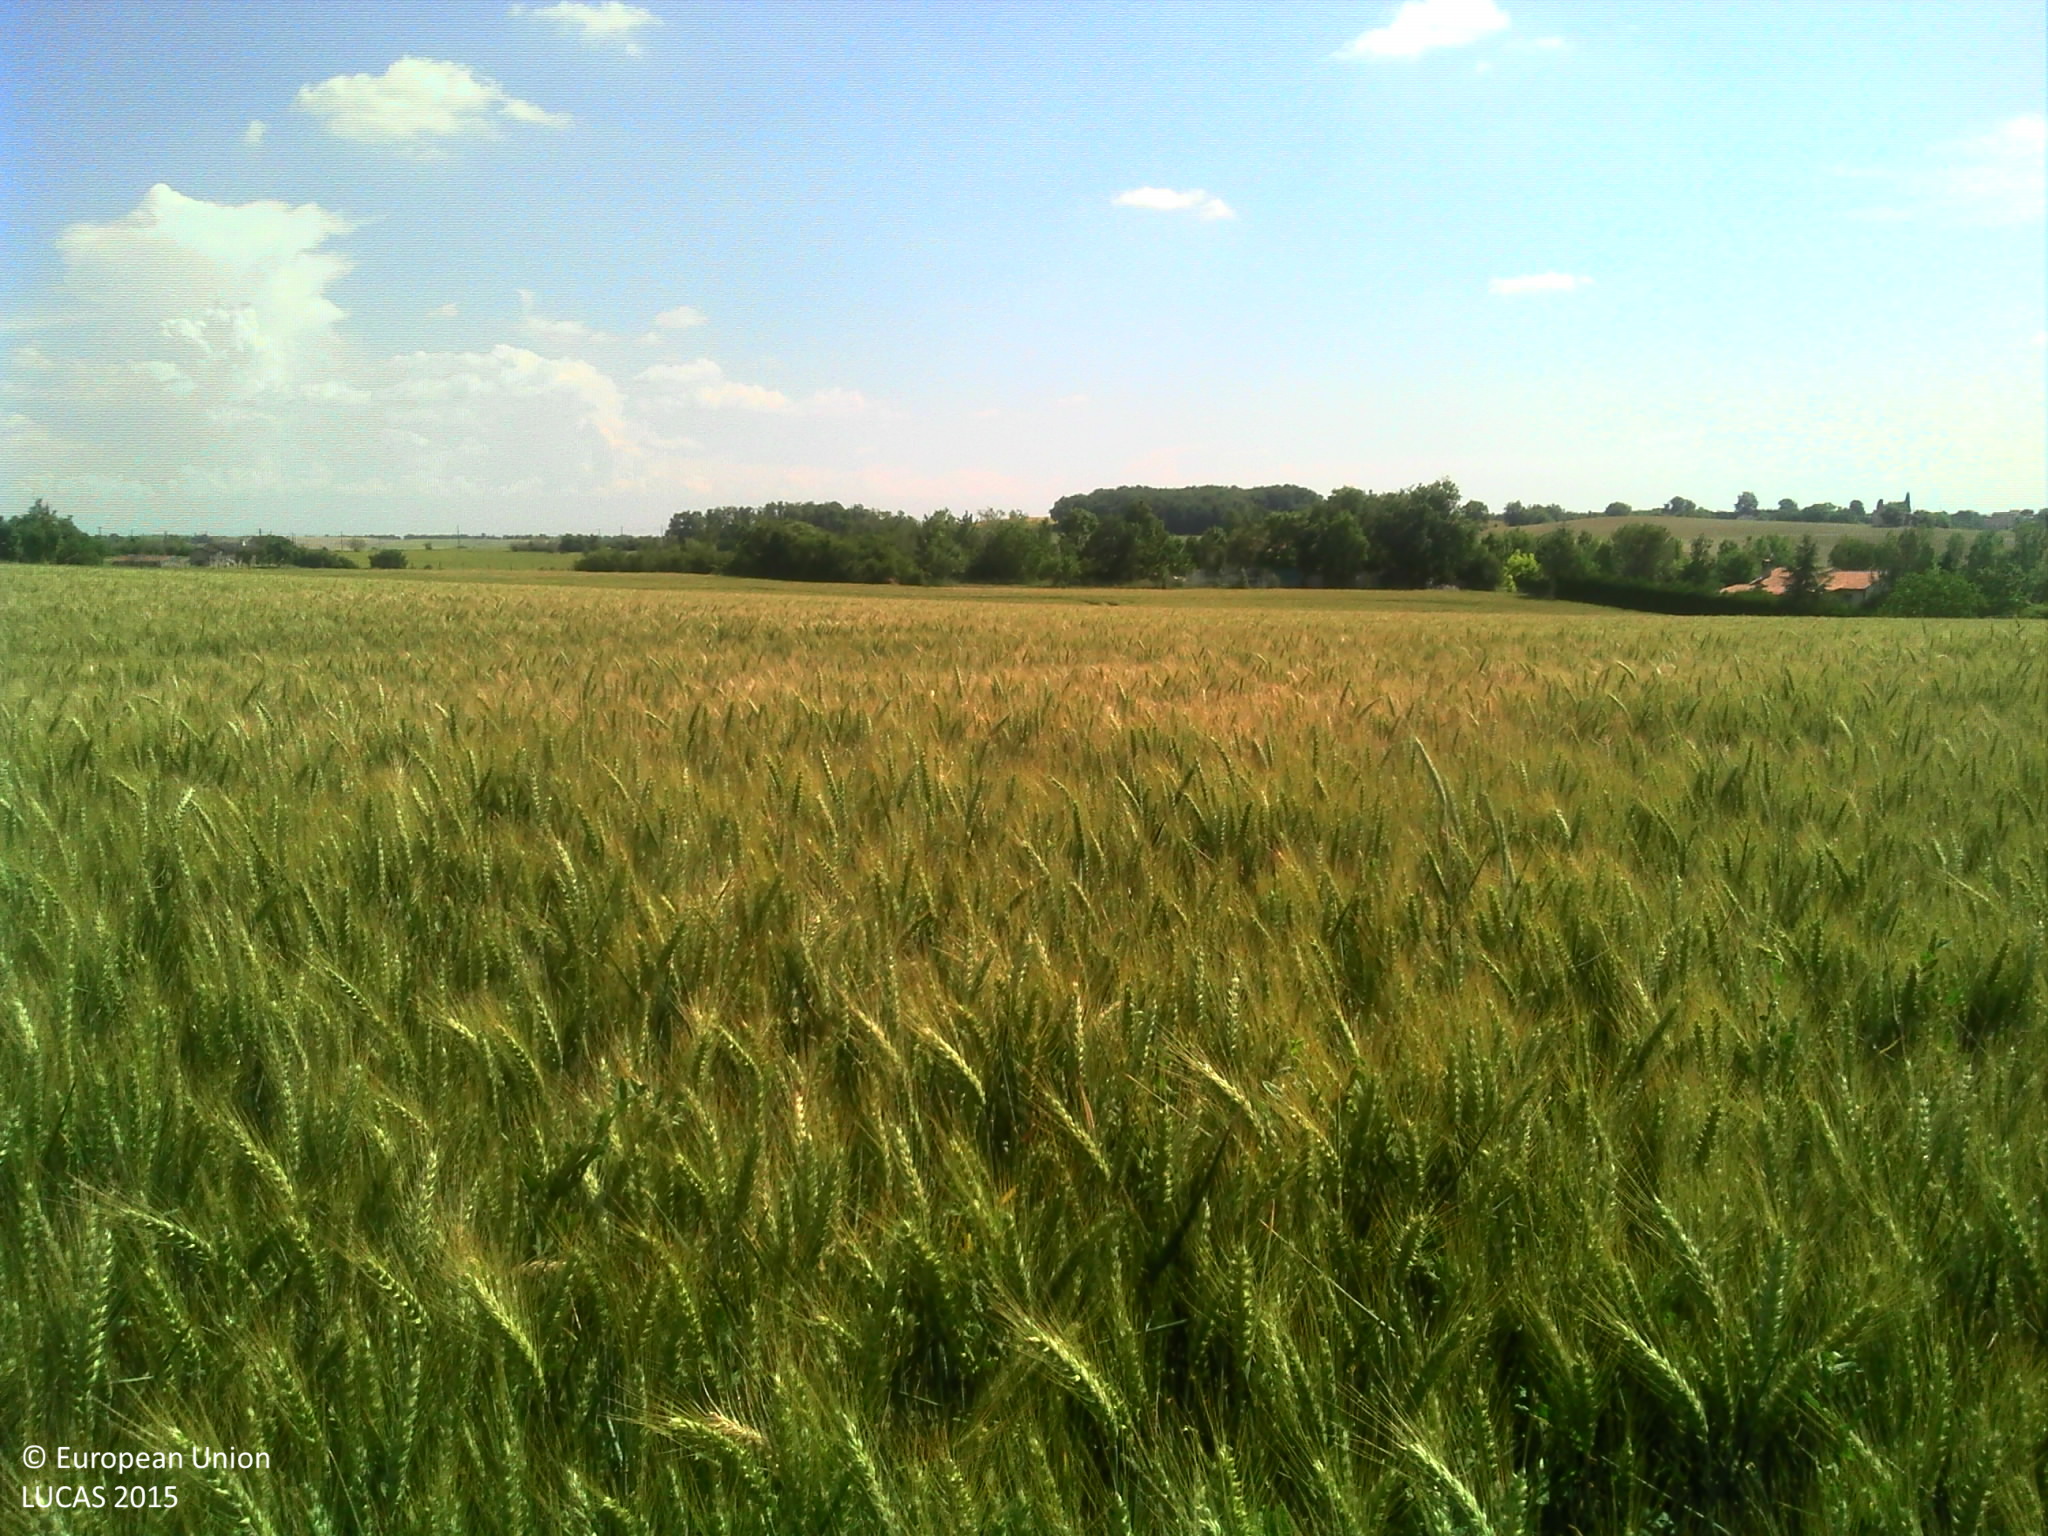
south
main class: Cropland
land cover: Common wheat
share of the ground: > 75 %
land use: Agriculture (excluding fallow land and kitchen gardens)
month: June
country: FR
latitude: 43.8501
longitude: 2.1049
